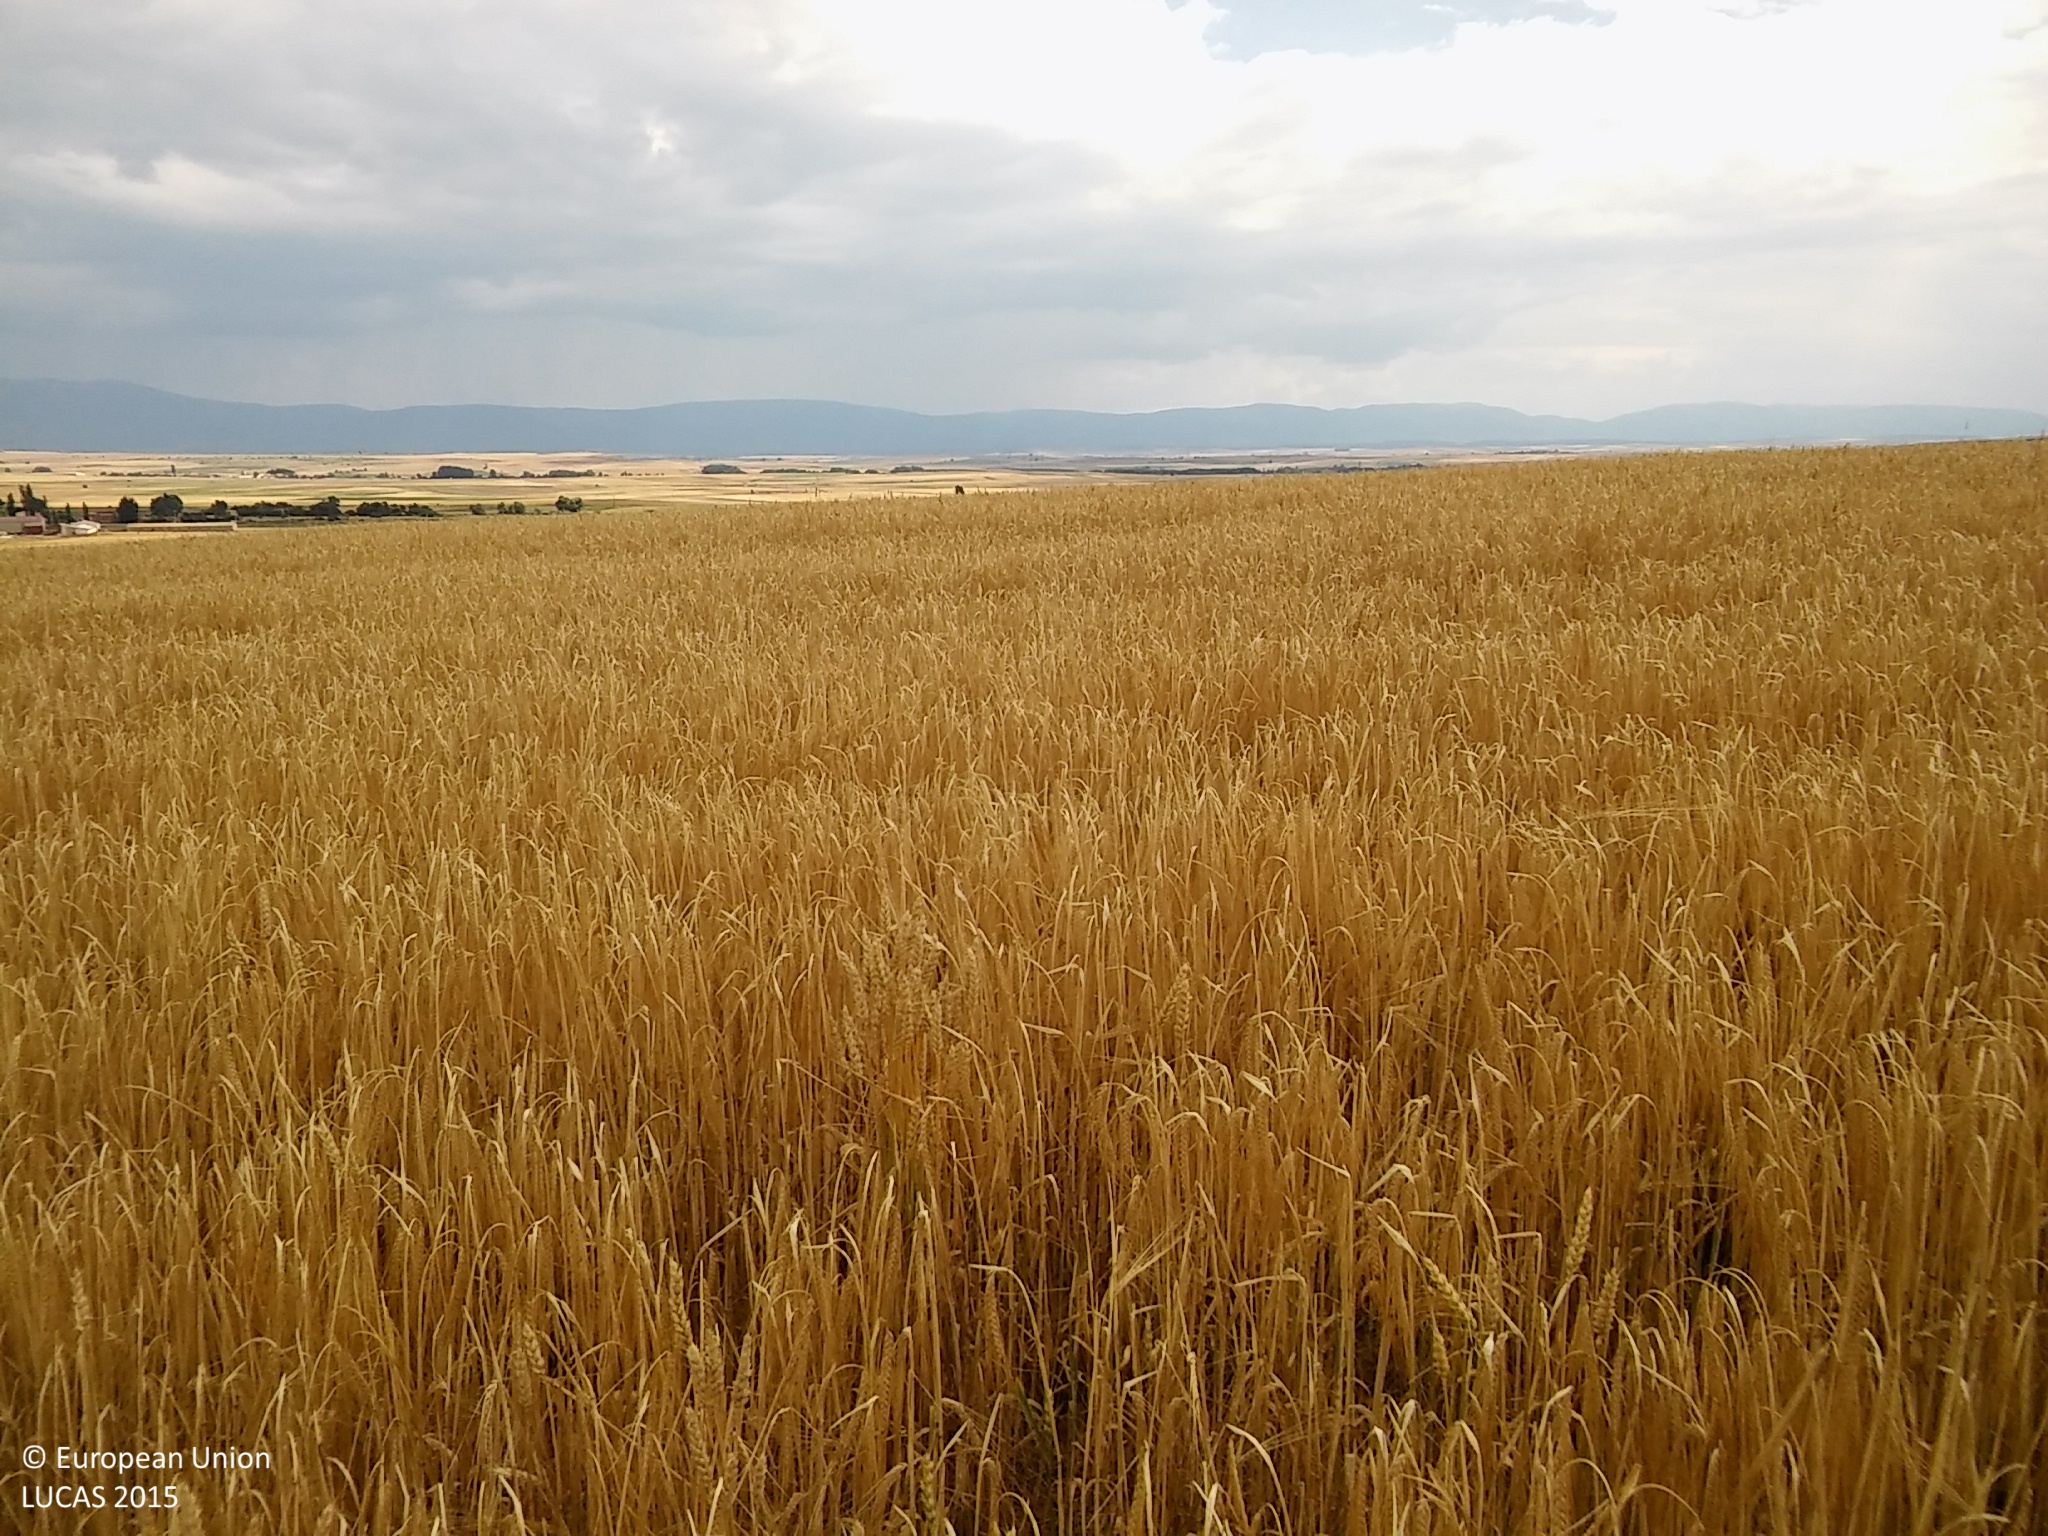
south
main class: Cropland
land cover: Barley
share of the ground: > 75 %
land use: Agriculture (excluding fallow land and kitchen gardens)
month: June
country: ES
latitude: 41.3363
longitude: -3.6830
